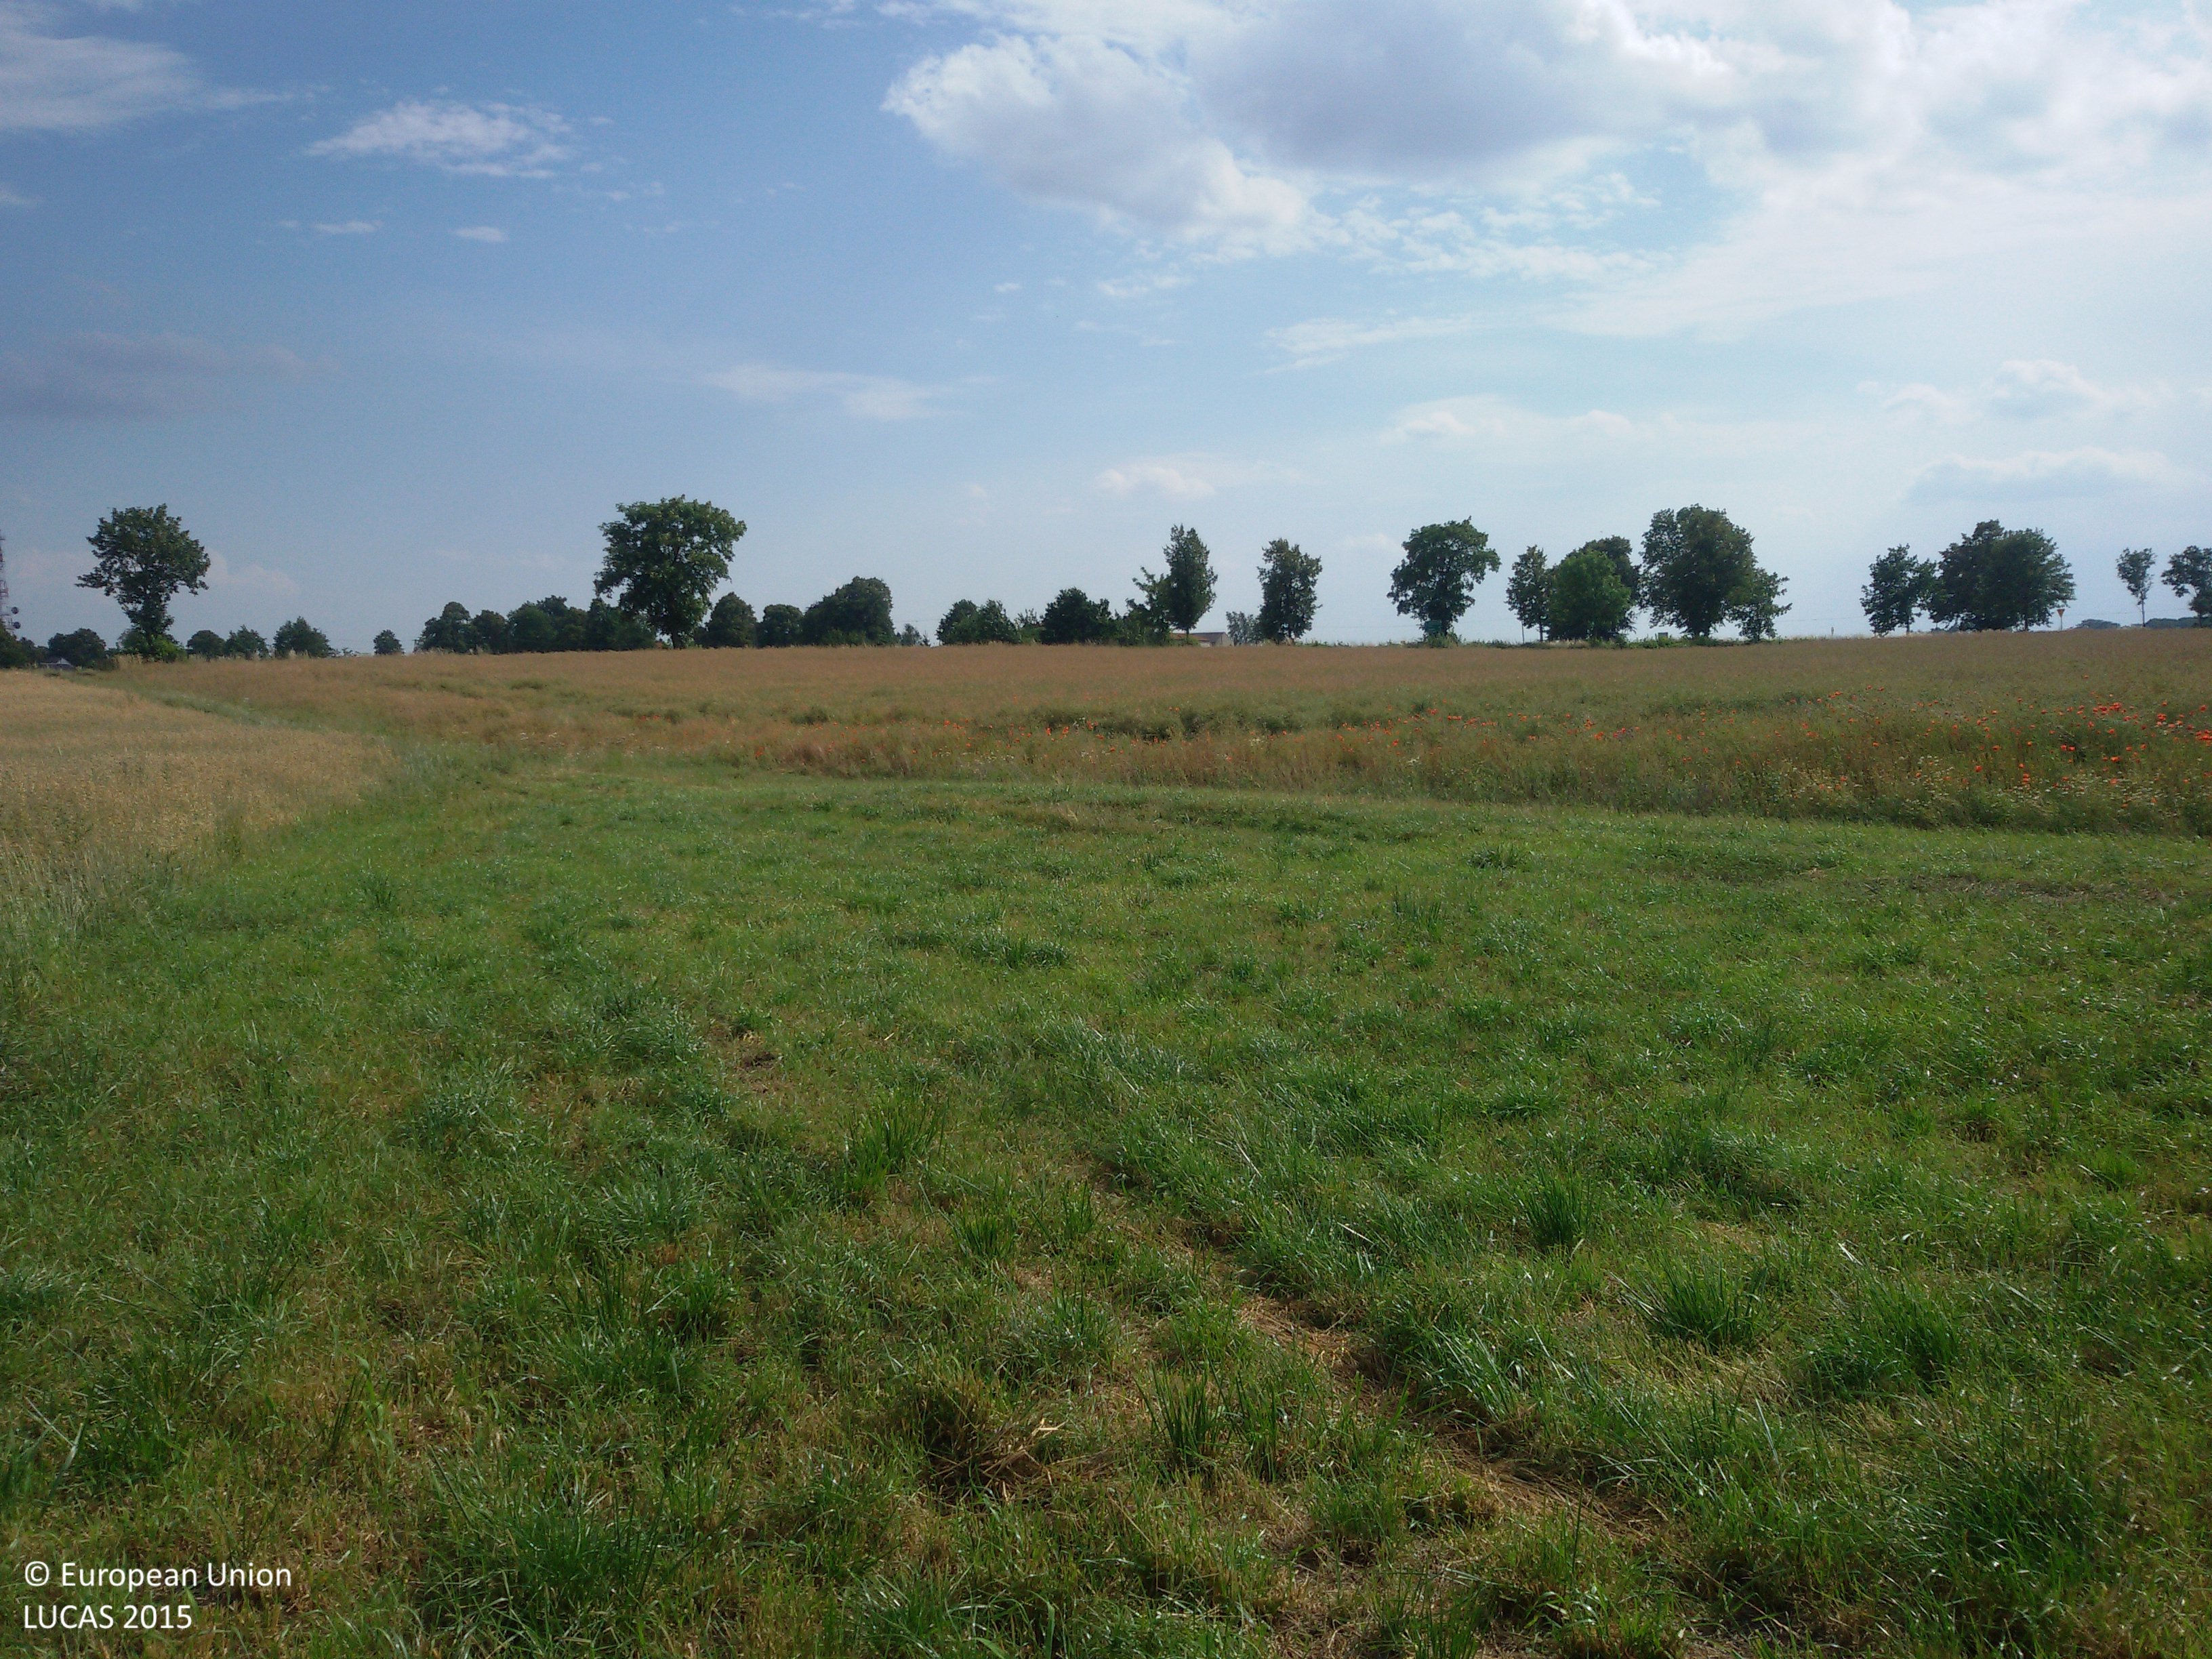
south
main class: Grassland
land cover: Grassland without tree/shrub cover
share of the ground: > 75 %
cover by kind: herbaceous plants 100 %
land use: Agriculture (excluding fallow land and kitchen gardens)
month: July
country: PL
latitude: 53.3718
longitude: 17.7236
